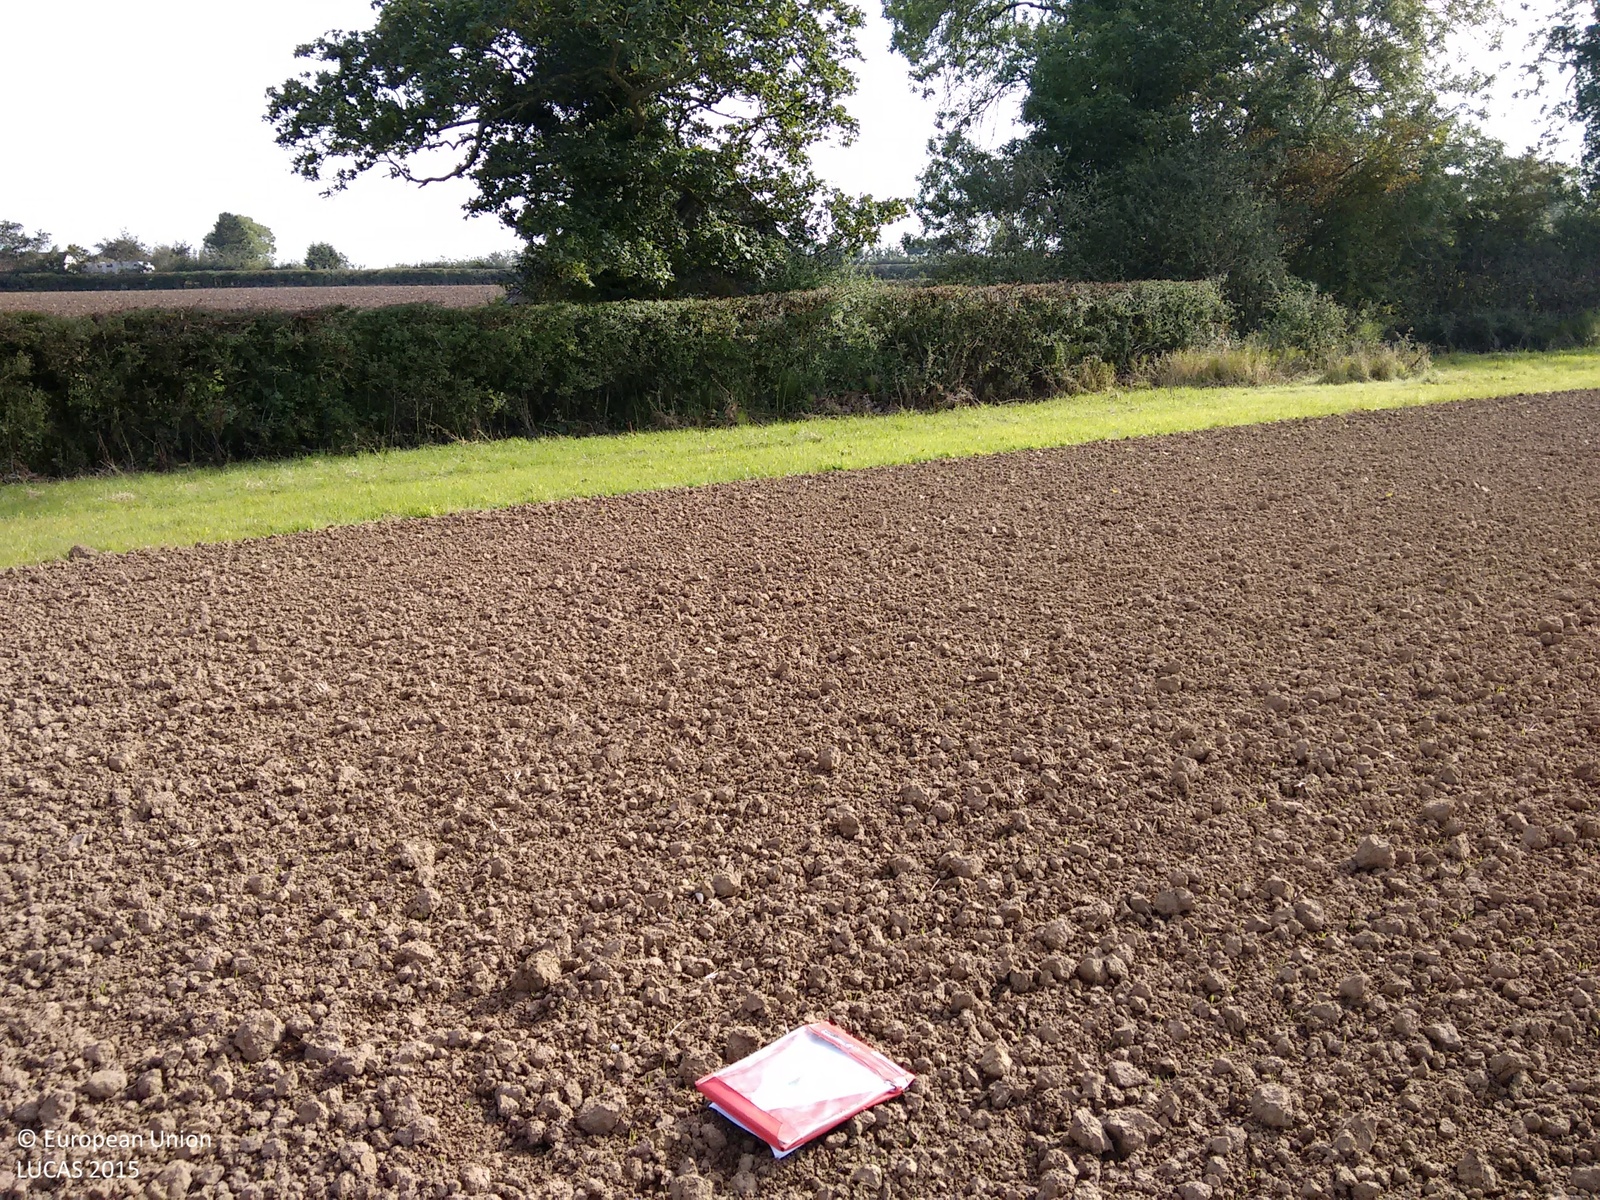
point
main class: Cropland
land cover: Barley
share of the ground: < 10 %
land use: Agriculture (excluding fallow land and kitchen gardens)
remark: Tilled/Sowed
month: September
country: GB
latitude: 51.5783
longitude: -2.4028
